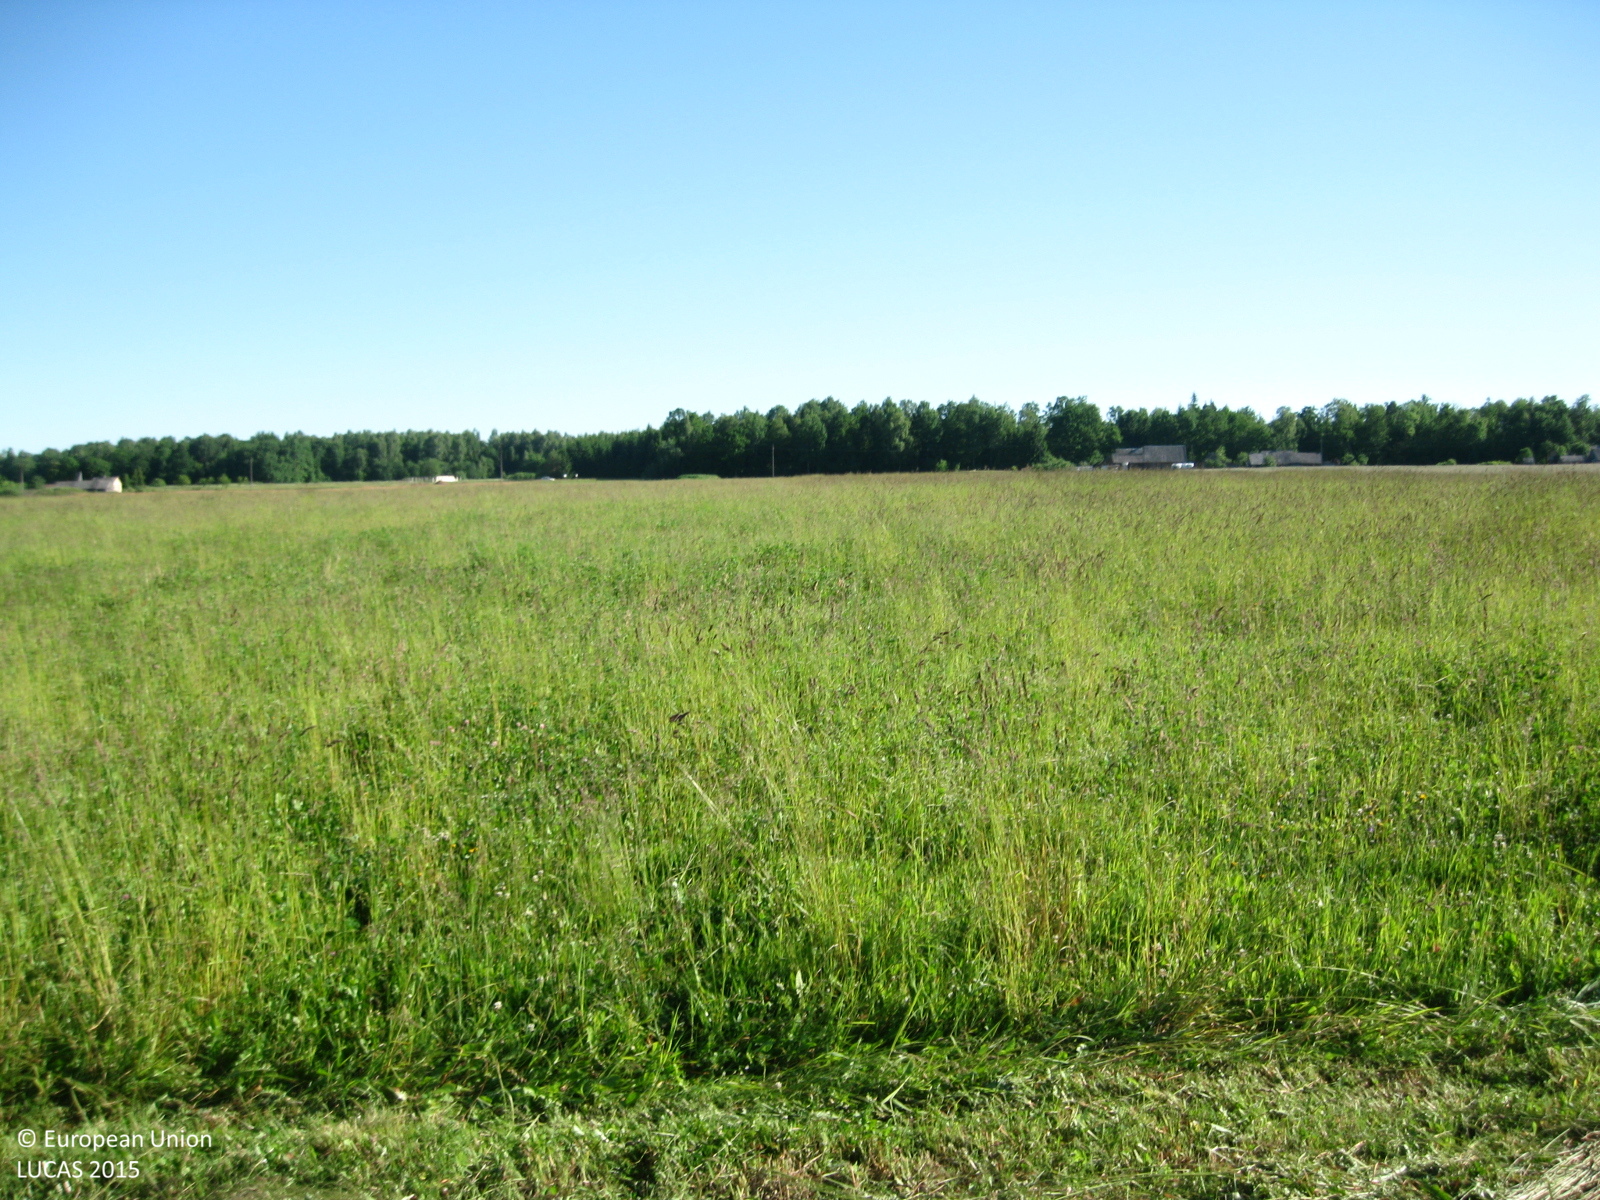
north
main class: Grassland
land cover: Grassland without tree/shrub cover
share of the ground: > 75 %
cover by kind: herbaceous plants 100 %
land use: Agriculture (excluding fallow land and kitchen gardens)
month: June
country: LT
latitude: 55.3505
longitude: 23.7581
